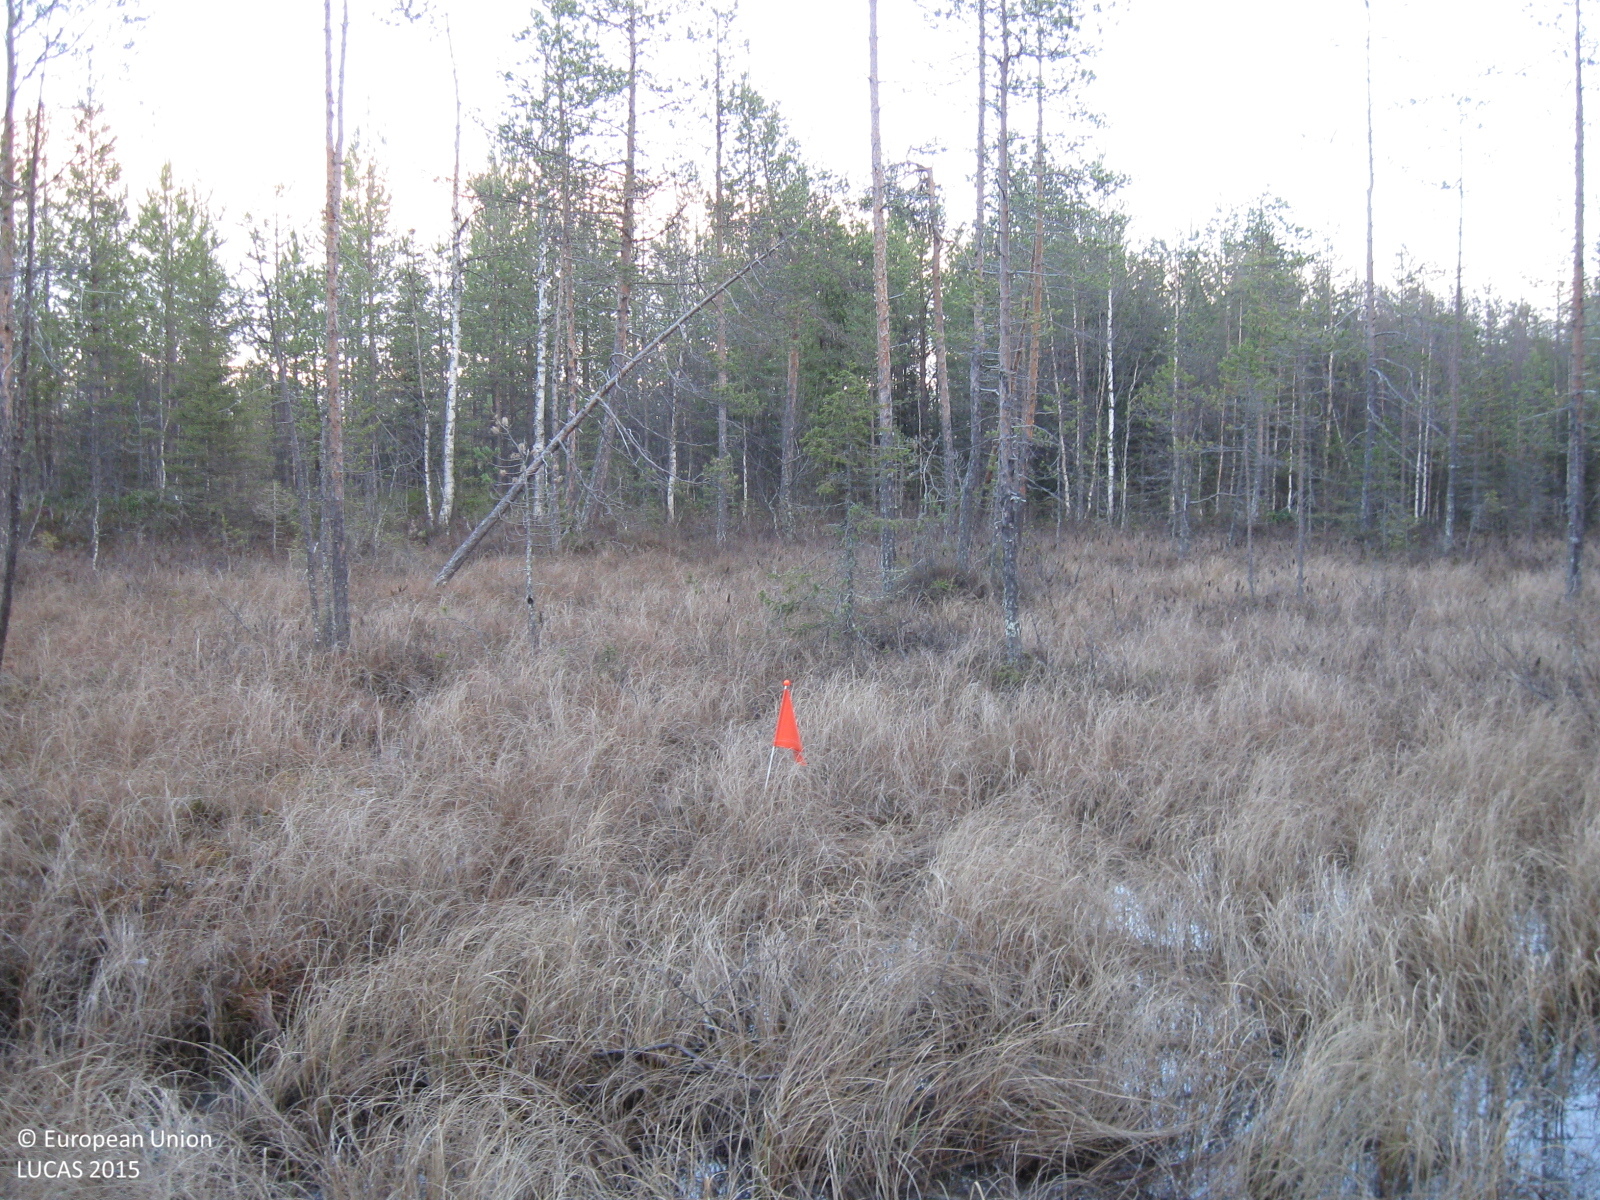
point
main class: Woodland
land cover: Pine dominated coniferous woodland
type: mire and swamp forests
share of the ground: 25 - 50 %
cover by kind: herbaceous plants 50 %, coniferous forest trees 30 %, shrubs 10 %, broadleaved forest trees 5 %, lichens and mosses 5 %
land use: Semi-natural and natural areas not in use
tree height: > 5 m
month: November
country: SE
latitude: 66.0381
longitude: 20.5312
